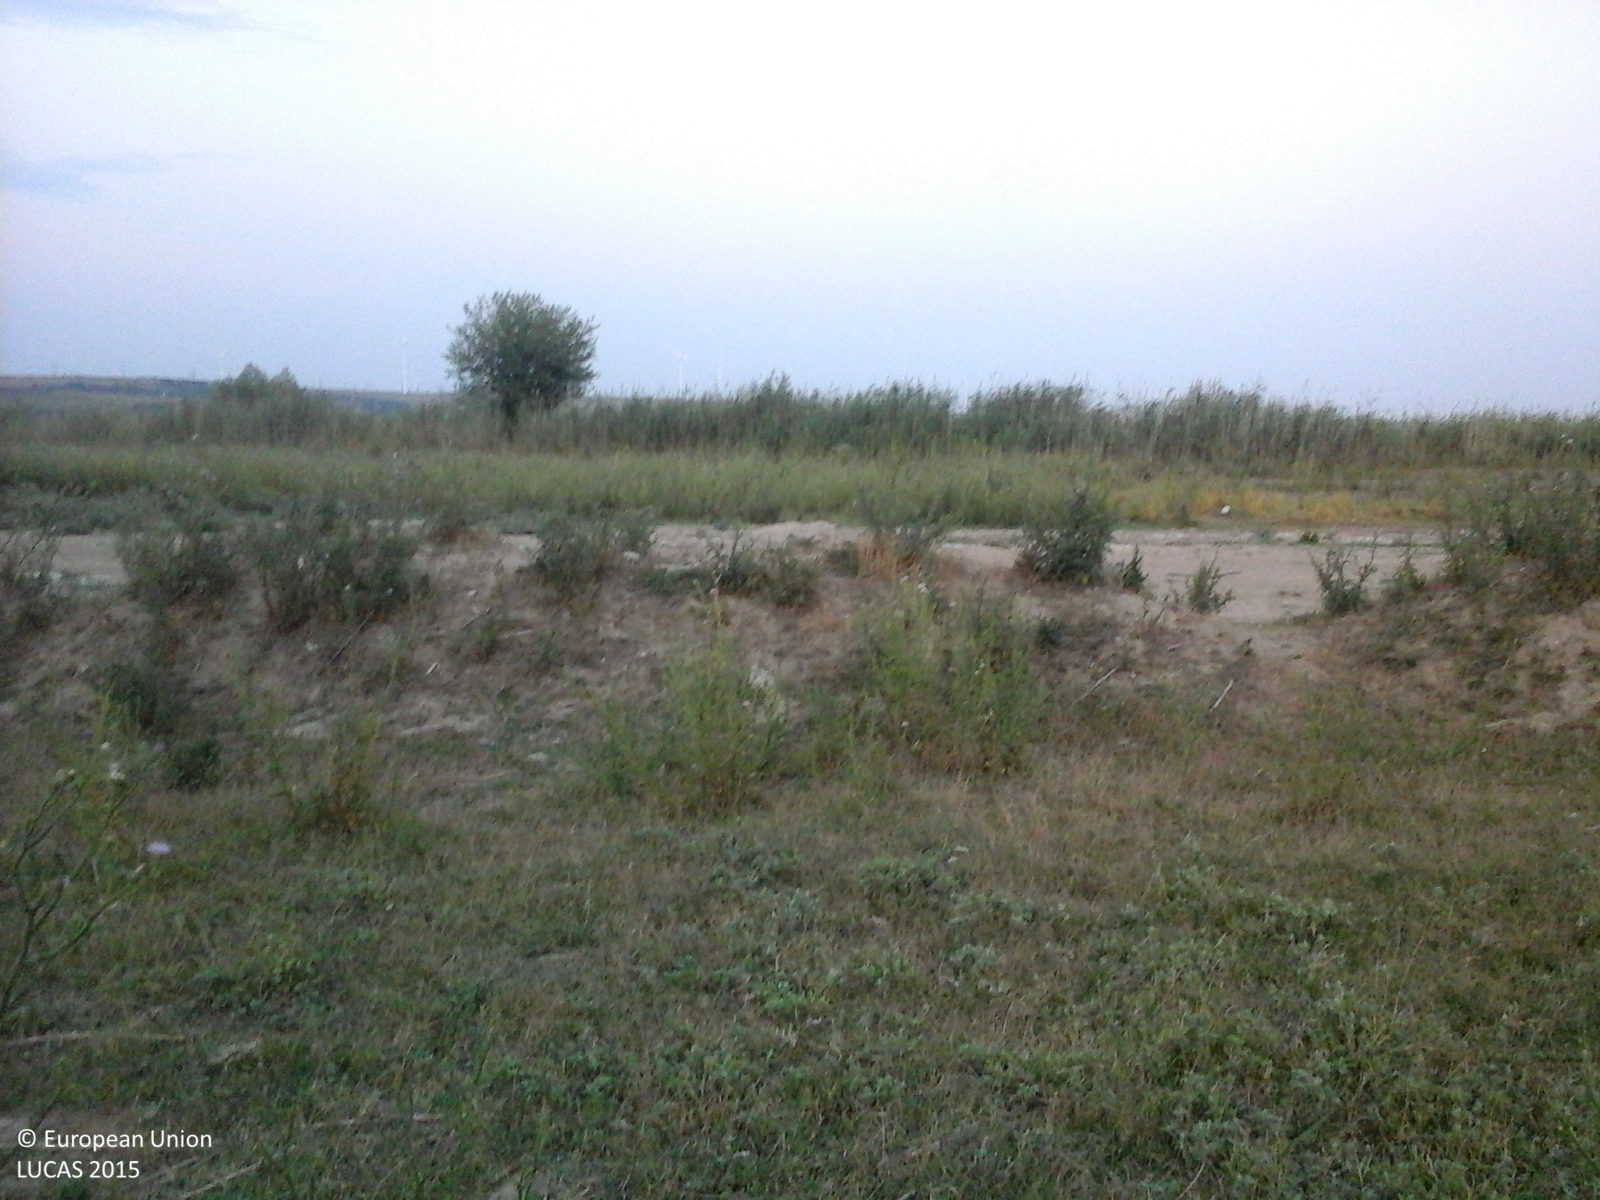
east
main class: Grassland
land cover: Spontaneously vegetated surfaces
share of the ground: > 75 %
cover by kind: herbaceous plants 100 %
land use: Semi-natural and natural areas not in use
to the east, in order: Spontaneously vegetated surfaces; Other bare soil; Spontaneously vegetated surfaces; Inland marshes; Ditches and canals; Single bushes/trees; Inland marshes; Lucerne
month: August
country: RO
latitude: 44.3021
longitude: 28.0438
